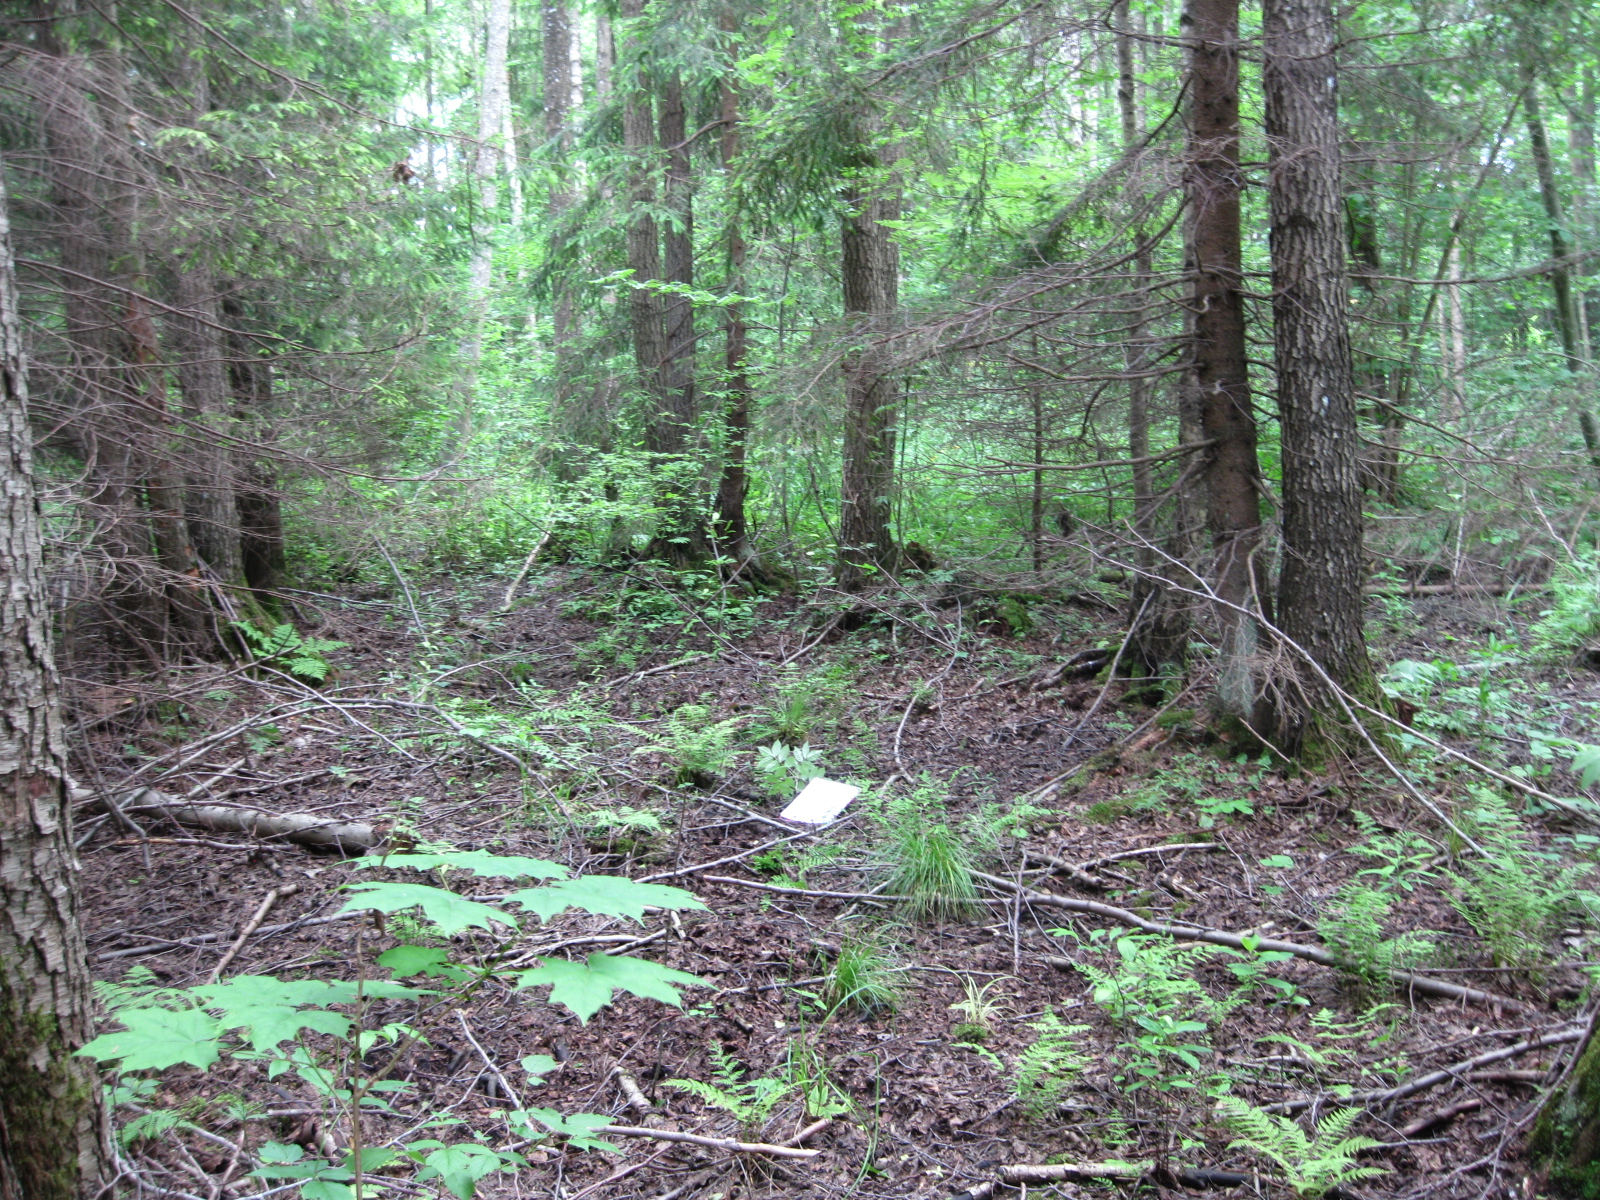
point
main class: Woodland
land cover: Spruce dominated mixed woodland
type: hemiboreal forest and nemoral coniferous forest and mixed broadleaved-coniferous forest
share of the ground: > 75 %
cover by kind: coniferous forest trees 55 %, broadleaved forest trees 30 %, unconsolidated bare surface 10 %, herbaceous plants 5 %
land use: Forestry
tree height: > 5 m
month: June
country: LT
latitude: 55.5198
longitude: 24.2057
